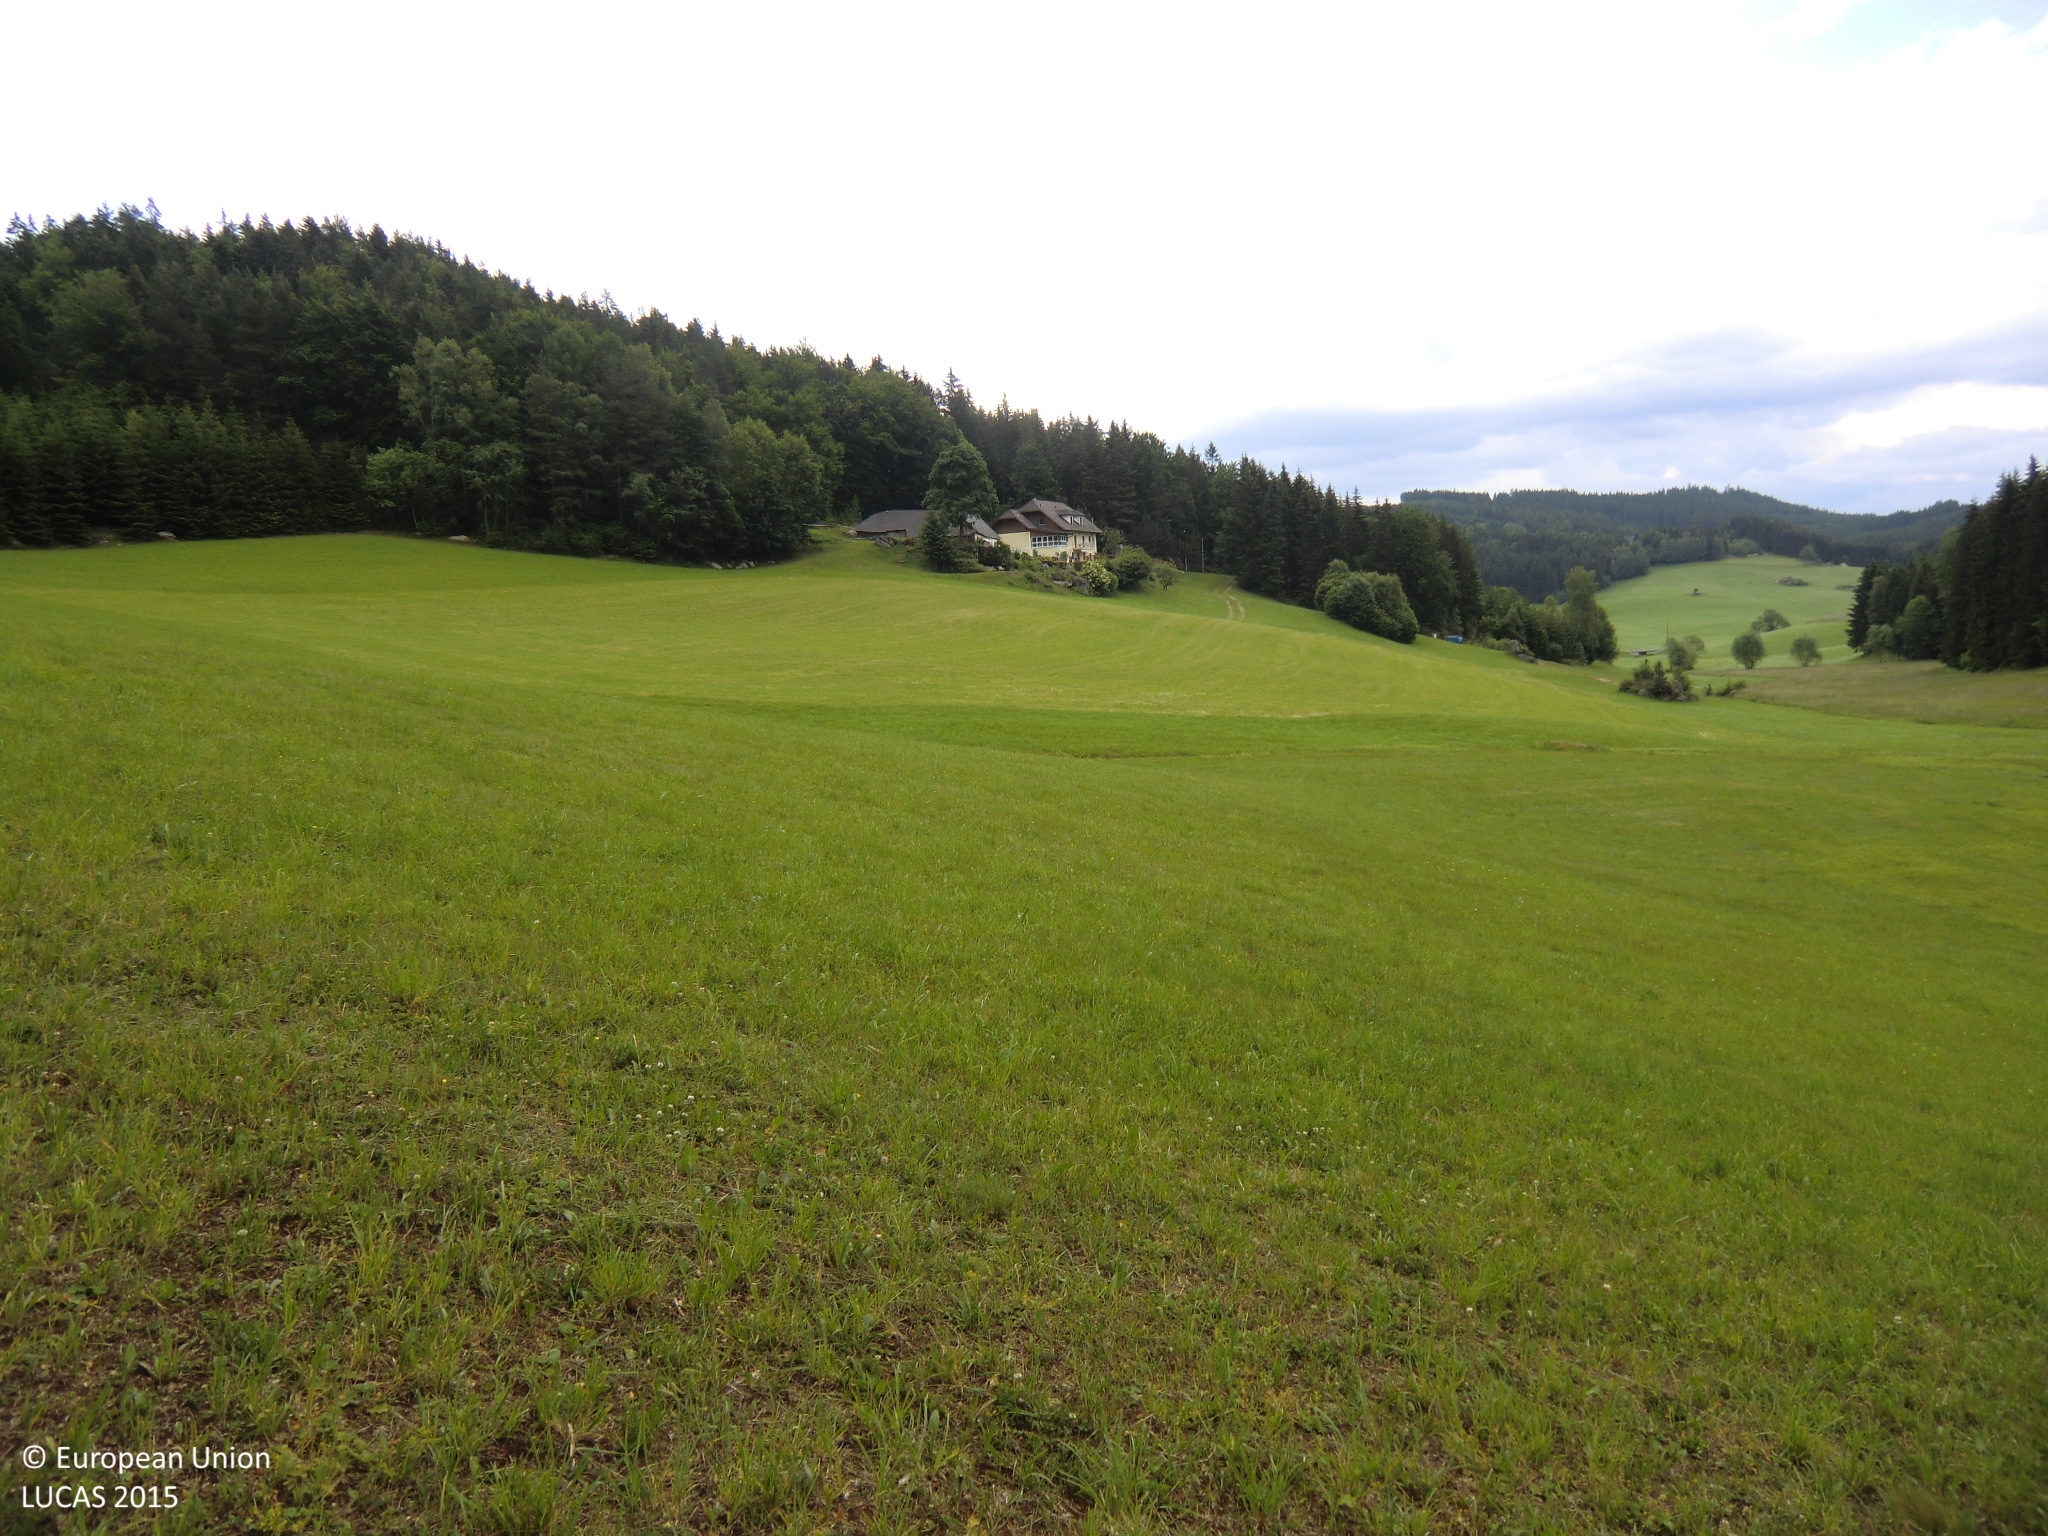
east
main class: Grassland
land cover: Grassland without tree/shrub cover
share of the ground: > 75 %
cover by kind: herbaceous plants 70 %, unconsolidated bare surface 30 %
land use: Agriculture (excluding fallow land and kitchen gardens)
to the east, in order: Grassland without tree/shrub cover; Rivers and streams; Grassland without tree/shrub cover; Pine dominated mixed woodland; Tracks; Pine dominated mixed woodland; Tracks; Pine dominated mixed woodland
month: June
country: AT
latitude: 48.4973
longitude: 14.8054
